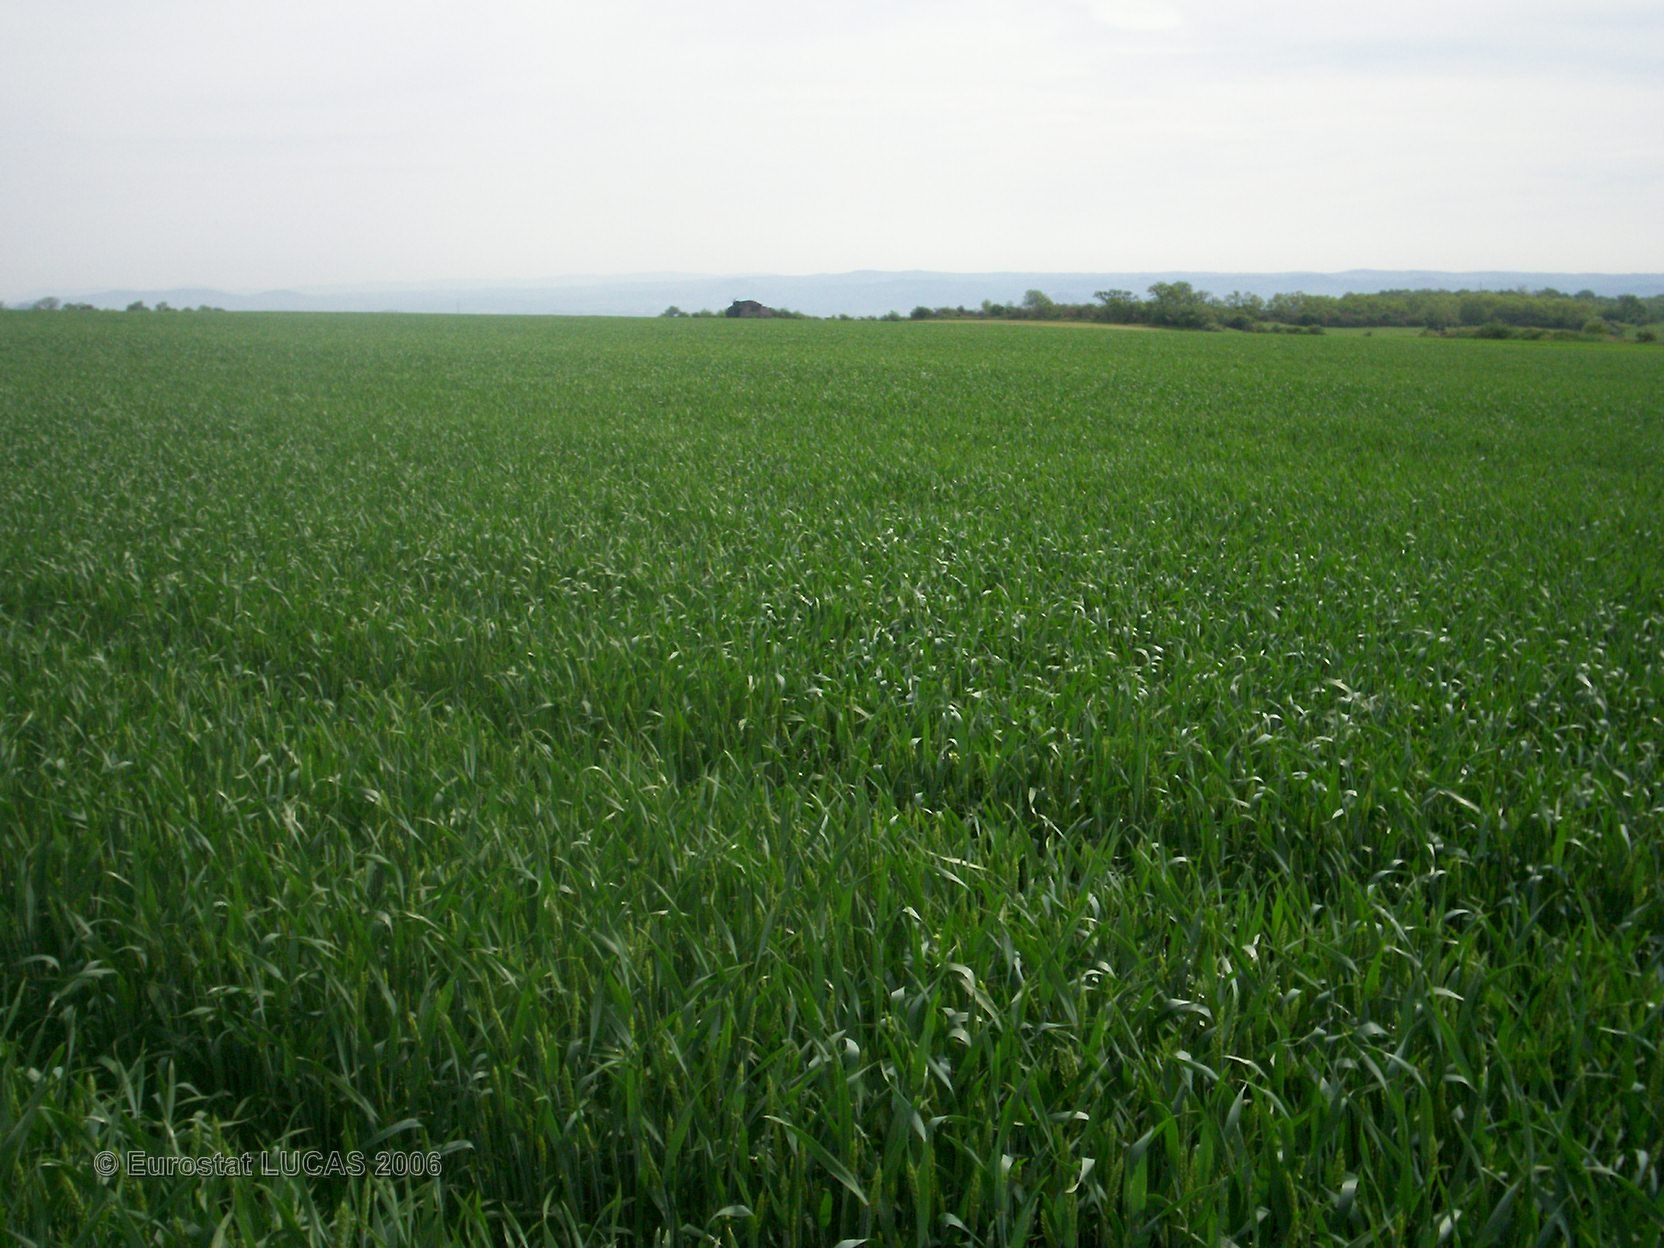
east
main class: Cropland
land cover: Common wheat
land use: Agriculture (excluding fallow land and kitchen gardens)
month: May
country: FR
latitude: 45.5203
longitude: 3.2029
